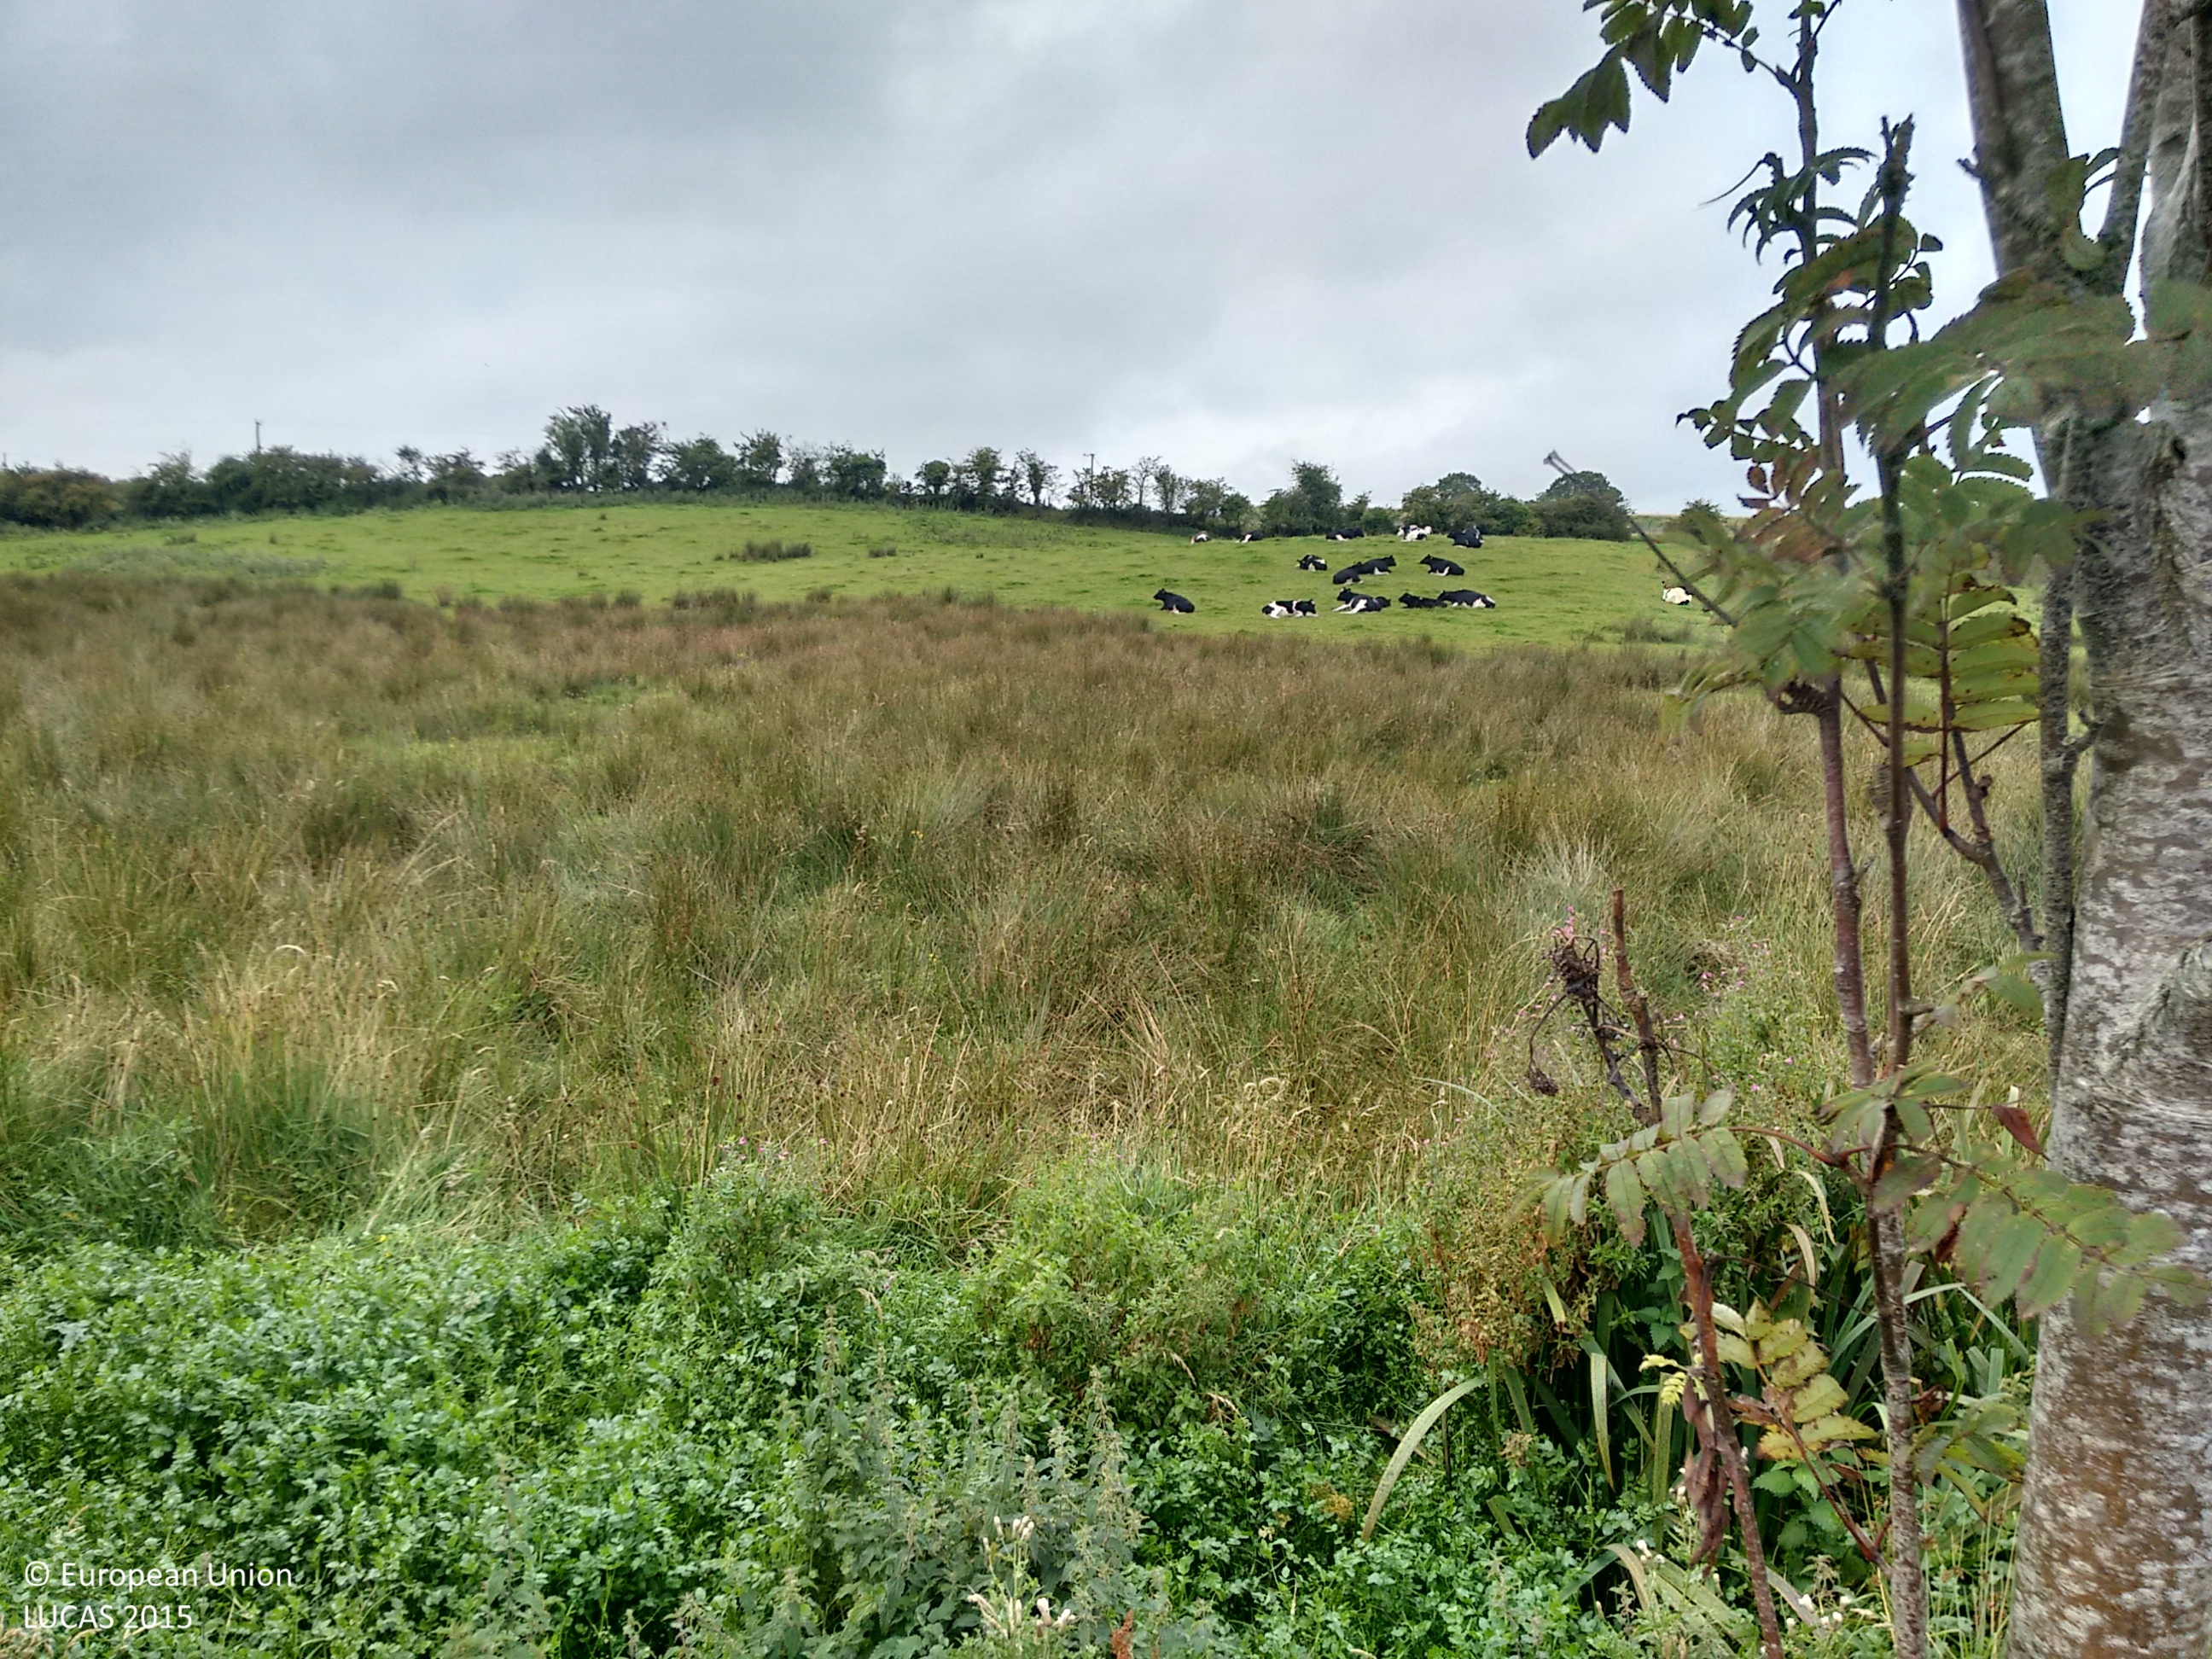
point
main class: Grassland
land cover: Grassland without tree/shrub cover
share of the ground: > 75 %
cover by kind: herbaceous plants 100 %
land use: Agriculture (excluding fallow land and kitchen gardens)
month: September
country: GB
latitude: 54.8619
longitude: -5.8556
